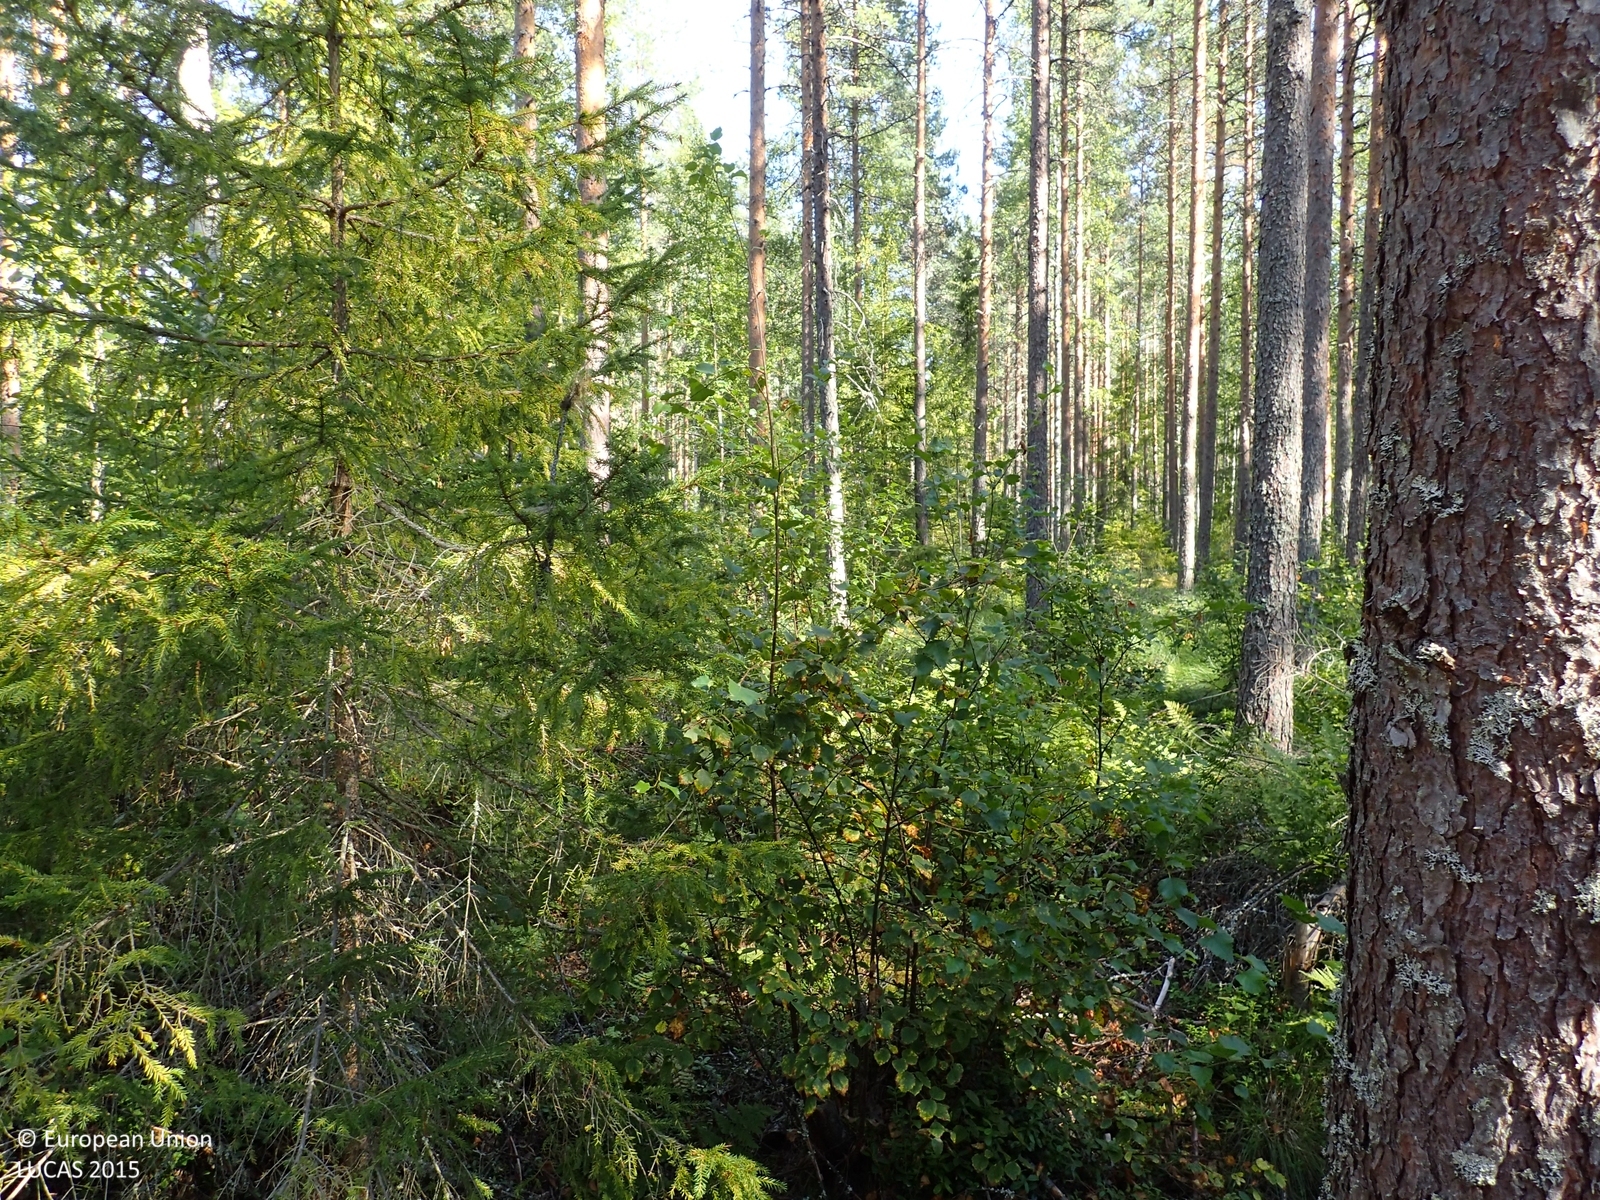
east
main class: Woodland
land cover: Pine dominated mixed woodland
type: boreal forest
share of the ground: > 75 %
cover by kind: coniferous forest trees 55 %, broadleaved forest trees 20 %, shrubs 10 %, herbaceous plants 10 %, lichens and mosses 5 %
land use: Forestry
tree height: > 5 m
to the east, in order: Pine dominated mixed woodland; Ditches and canals; Pine dominated mixed woodland; Ditches and canals; Pine dominated mixed woodland; Ditches and canals; Pine dominated mixed woodland; Ditches and canals; Pine dominated mixed woodland
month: August
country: FI
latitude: 62.5625
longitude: 21.8550
